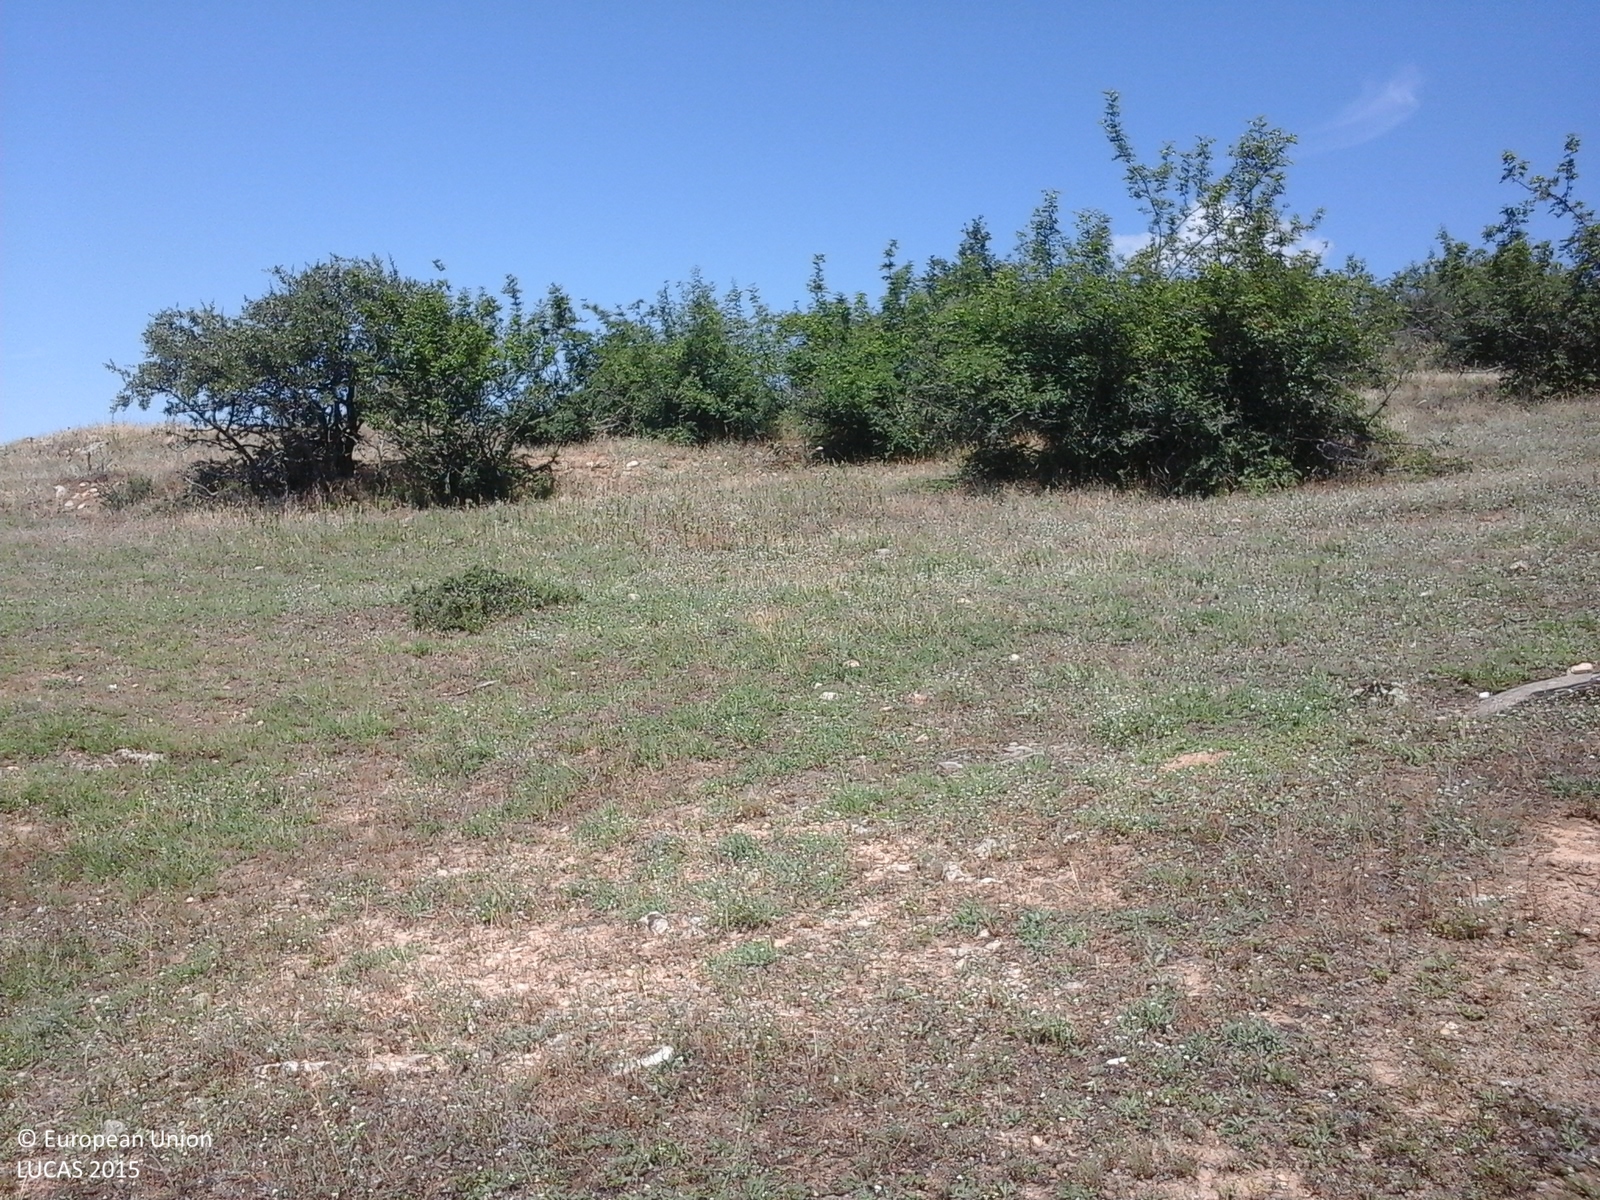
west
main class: Shrubland
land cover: Shrubland without tree cover
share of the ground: 50 - 75 %
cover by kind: shrubs 50 %, herbaceous plants 50 %
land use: Semi-natural and natural areas not in use
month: June
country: GR
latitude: 40.7771
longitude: 23.2234
